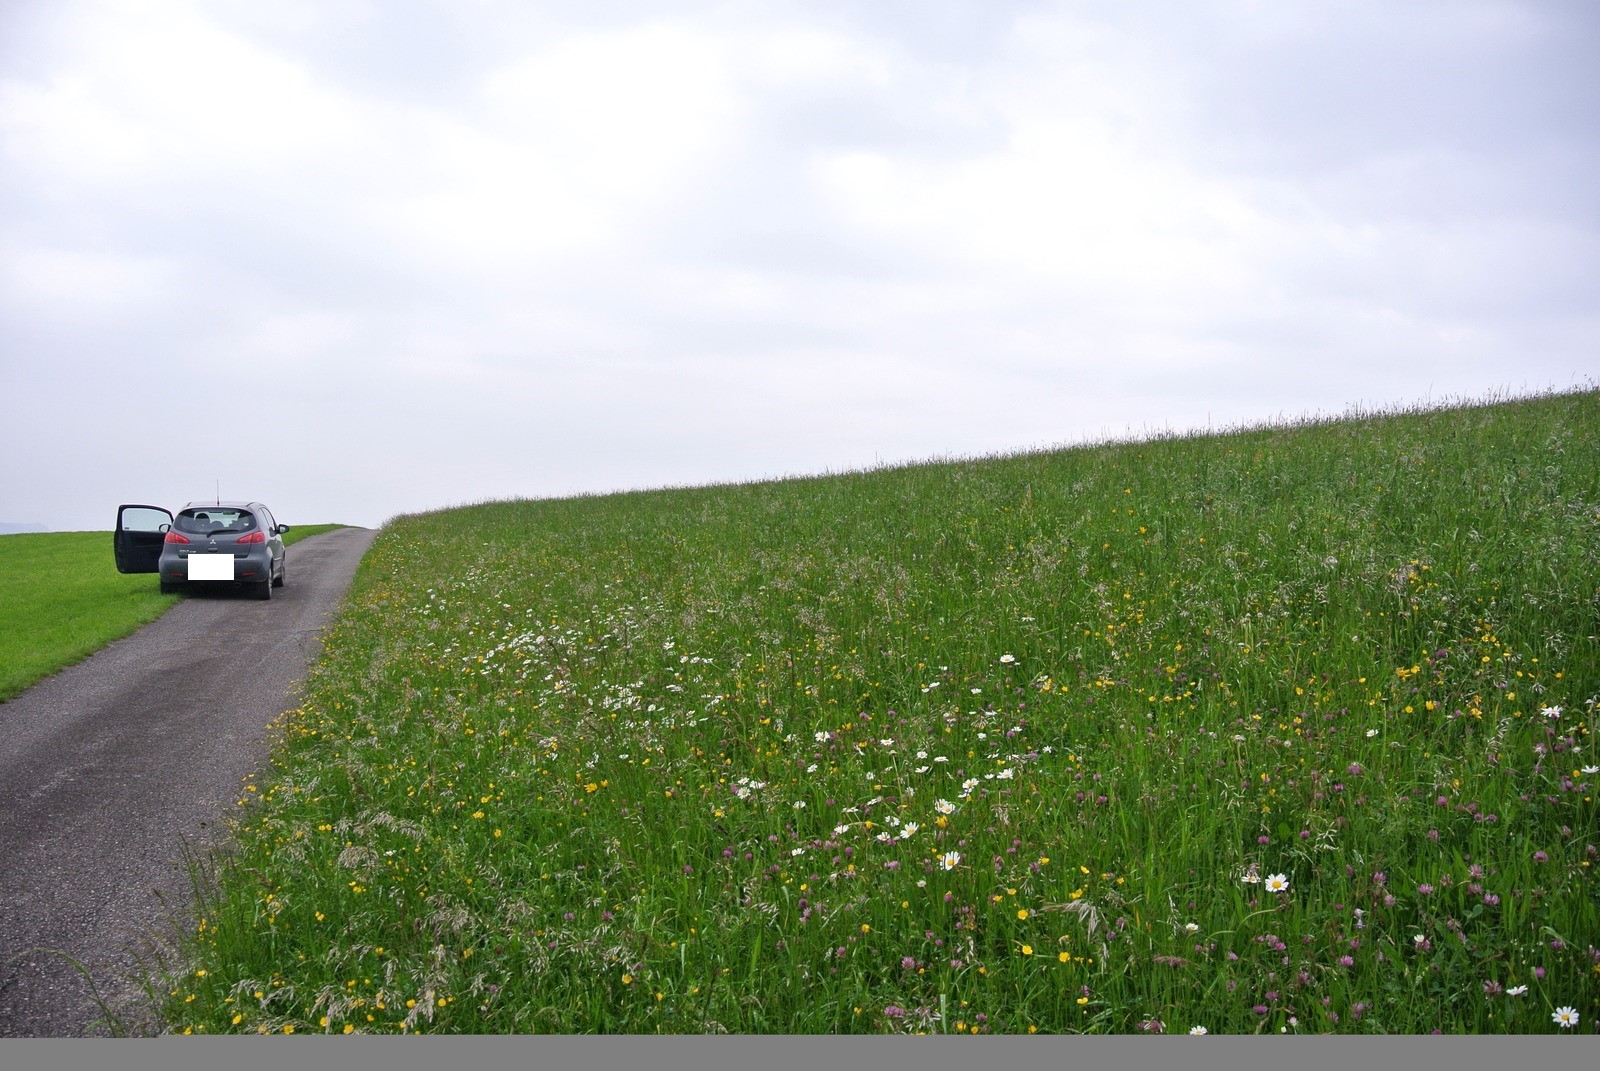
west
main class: Grassland
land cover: Grassland without tree/shrub cover
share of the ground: > 75 %
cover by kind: herbaceous plants 100 %
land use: Agriculture (excluding fallow land and kitchen gardens)
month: May
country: AT
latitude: 48.1074
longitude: 15.7914
